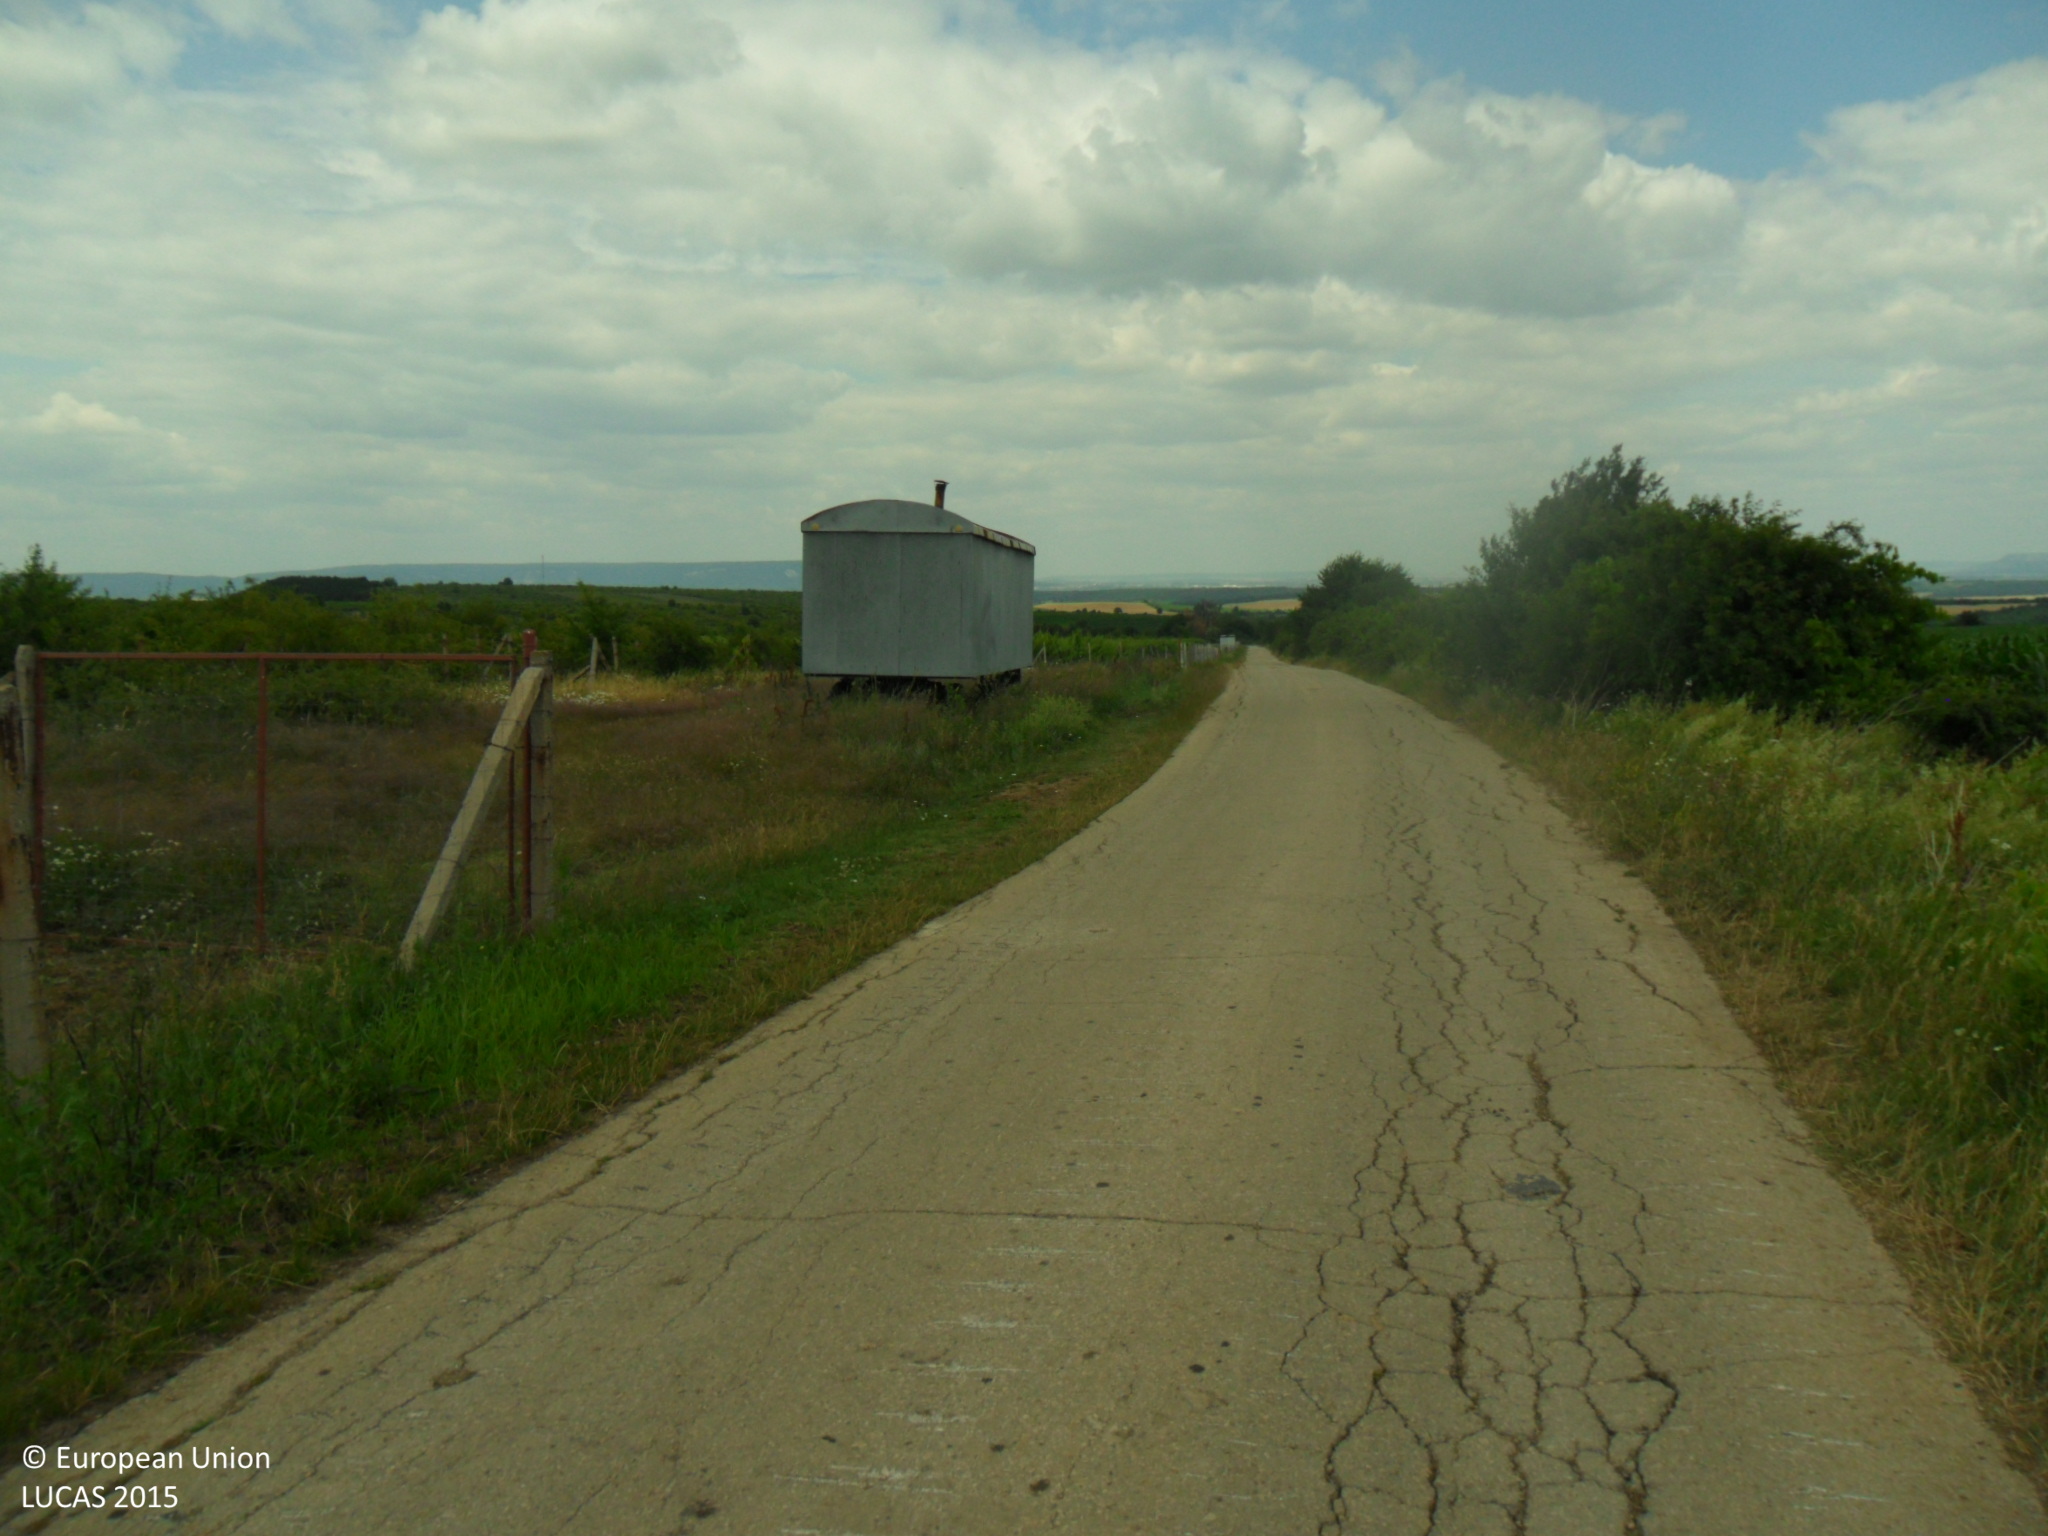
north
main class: Cropland
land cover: Vineyards
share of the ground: 10 - 25 %
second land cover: Other bare soil
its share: > 75 %
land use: Agriculture (excluding fallow land and kitchen gardens)
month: June
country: BG
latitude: 43.1024
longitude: 26.8814
